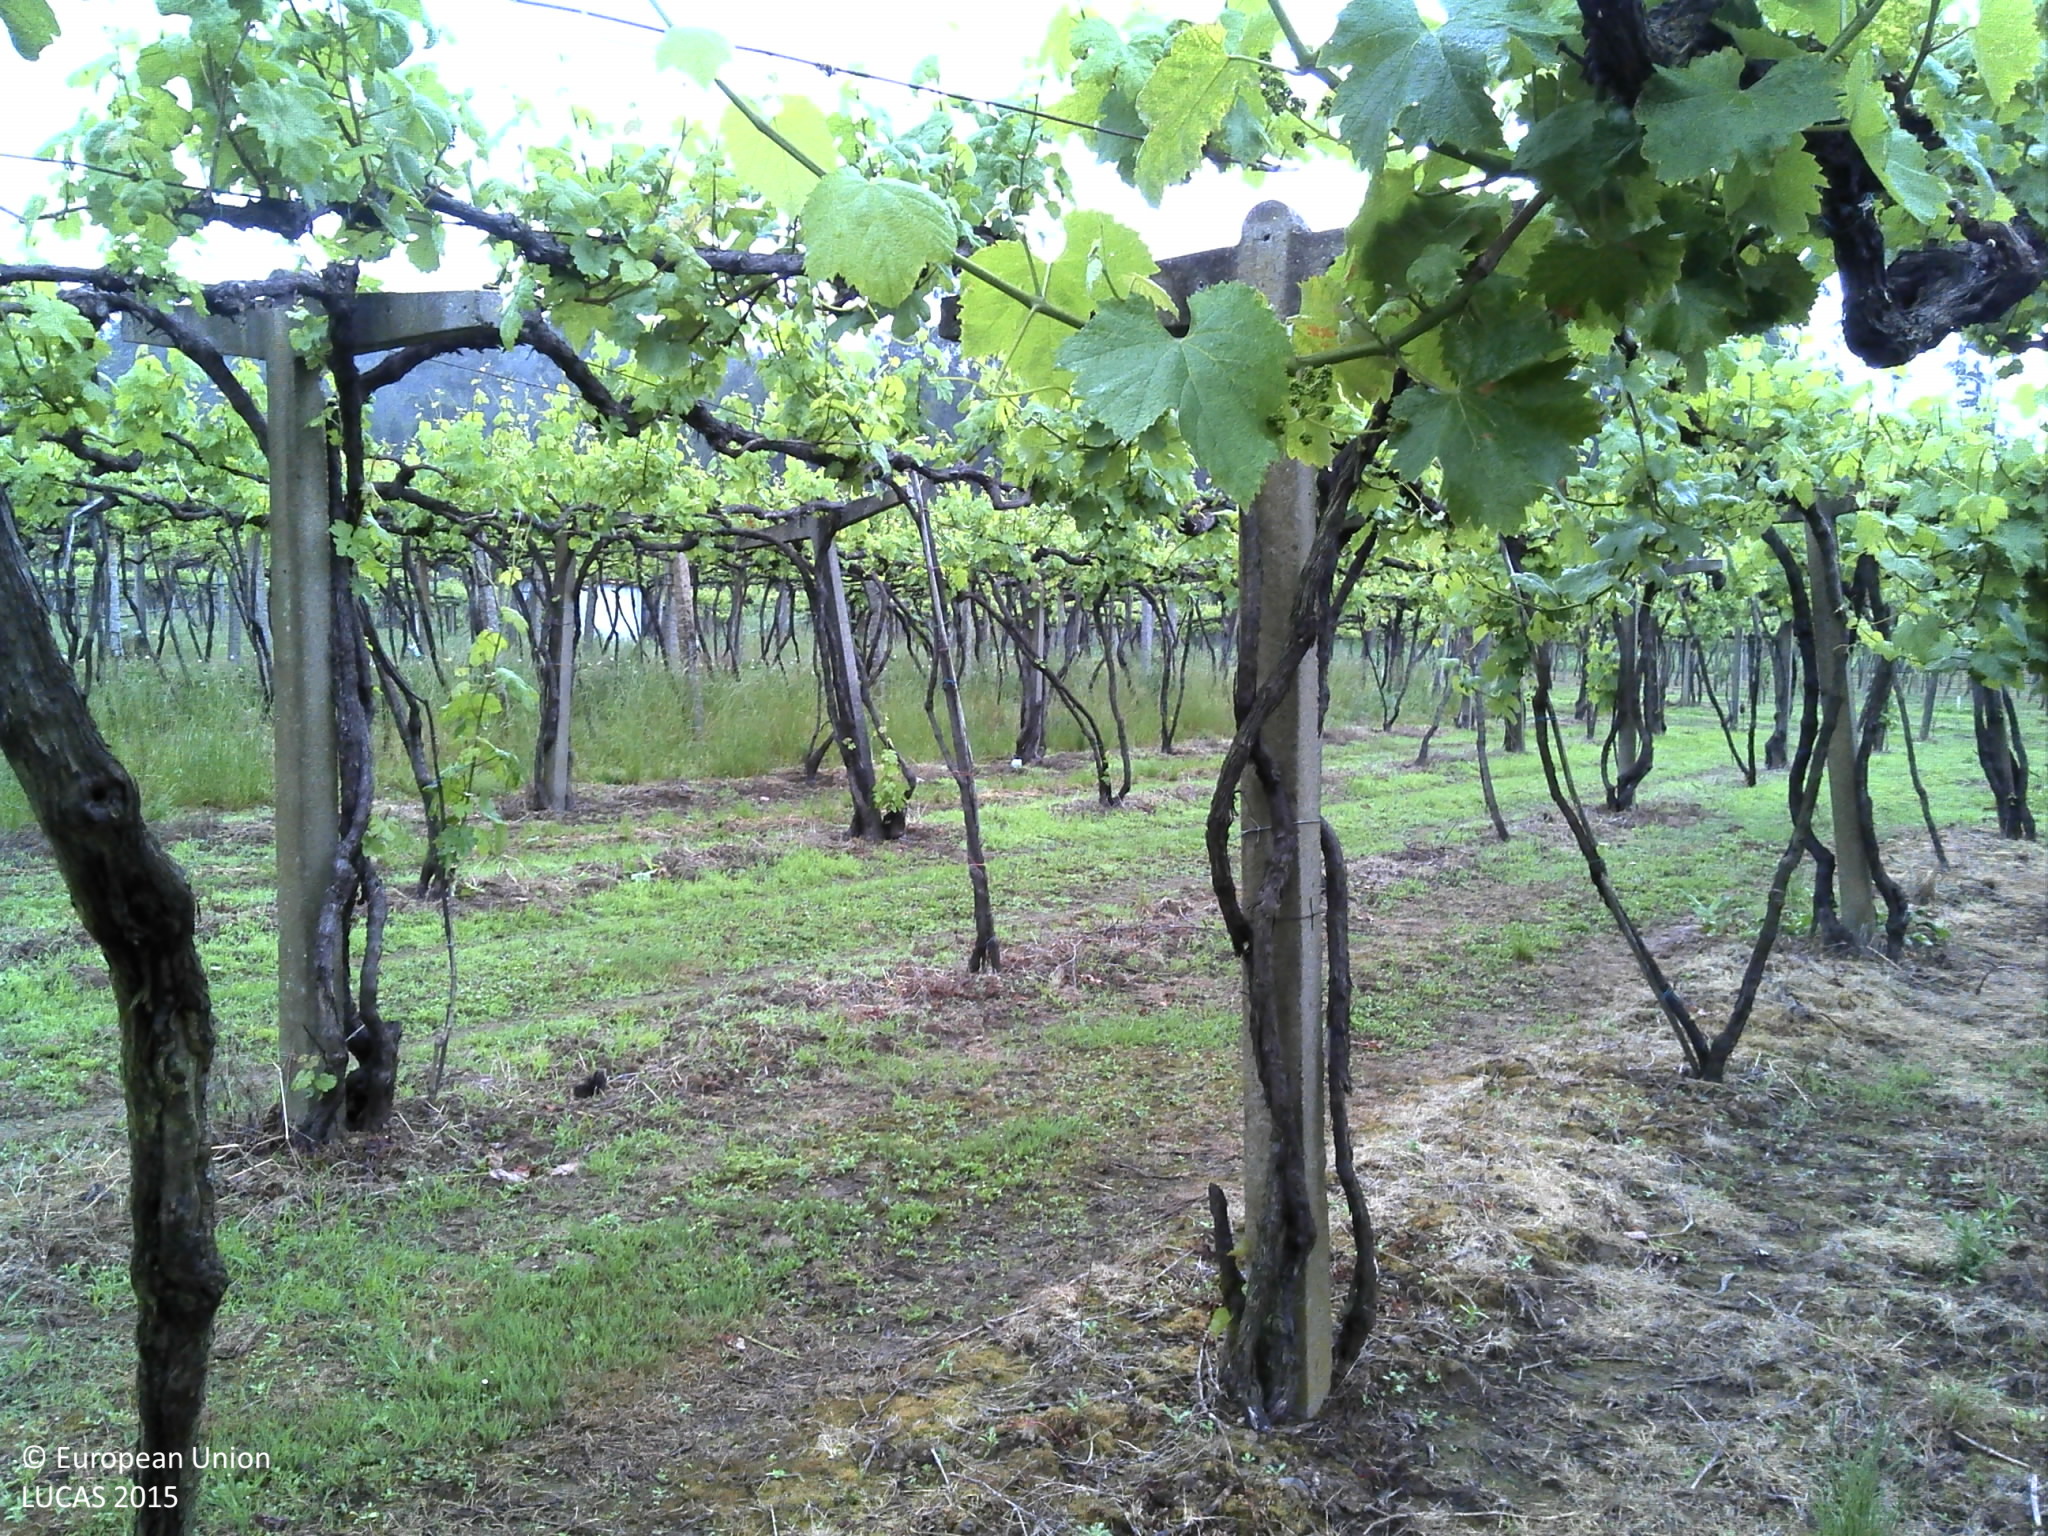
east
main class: Cropland
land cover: Vineyards
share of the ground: 50 - 75 %
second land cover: Grassland without tree/shrub cover
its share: 10 - 25 %
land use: Agriculture (excluding fallow land and kitchen gardens)
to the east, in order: Vineyards; Grassland without tree/shrub cover; Electric lines; Vineyards; Rivers and streams; Other fresh vegetables; Broadleaved woodland; Tracks; Broadleaved woodland; Tracks; Broadleaved woodland
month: May
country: PT
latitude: 41.1997
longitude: -8.4530
